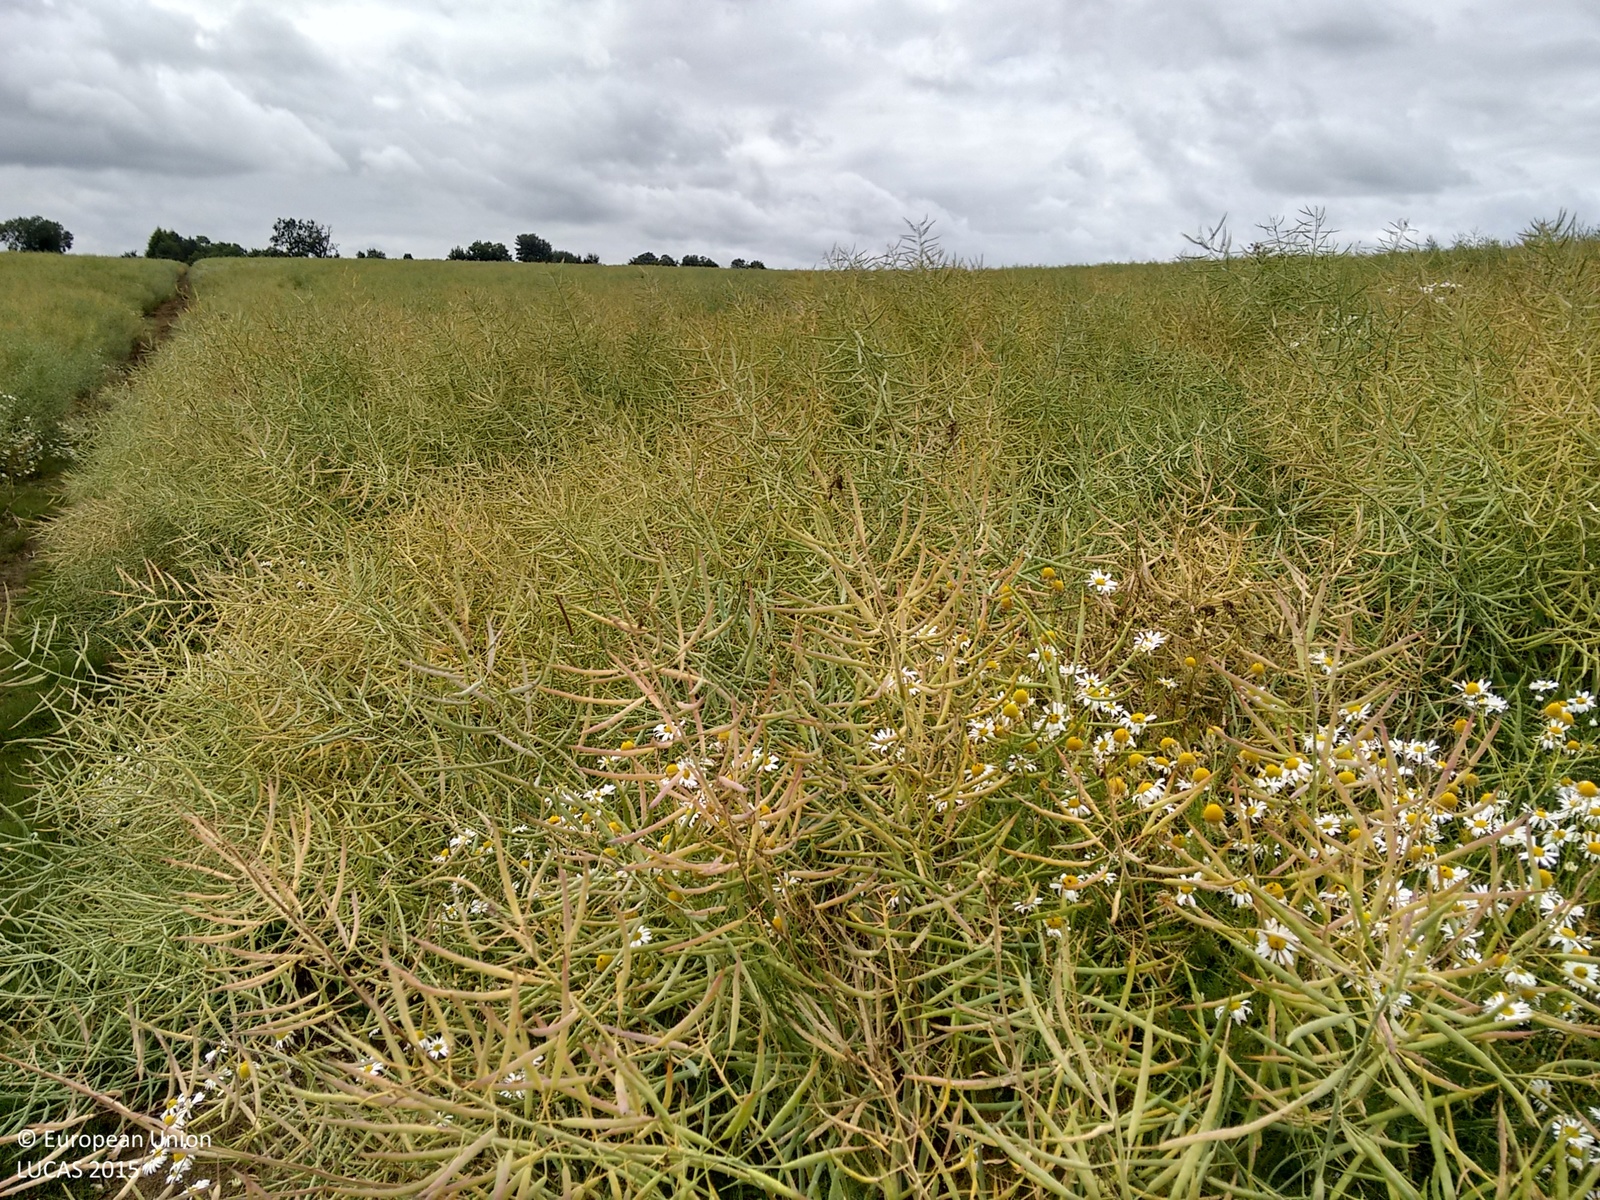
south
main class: Cropland
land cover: Rape and turnip rape
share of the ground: > 75 %
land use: Agriculture (excluding fallow land and kitchen gardens)
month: July
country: GB
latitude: 52.6863
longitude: -0.9462
